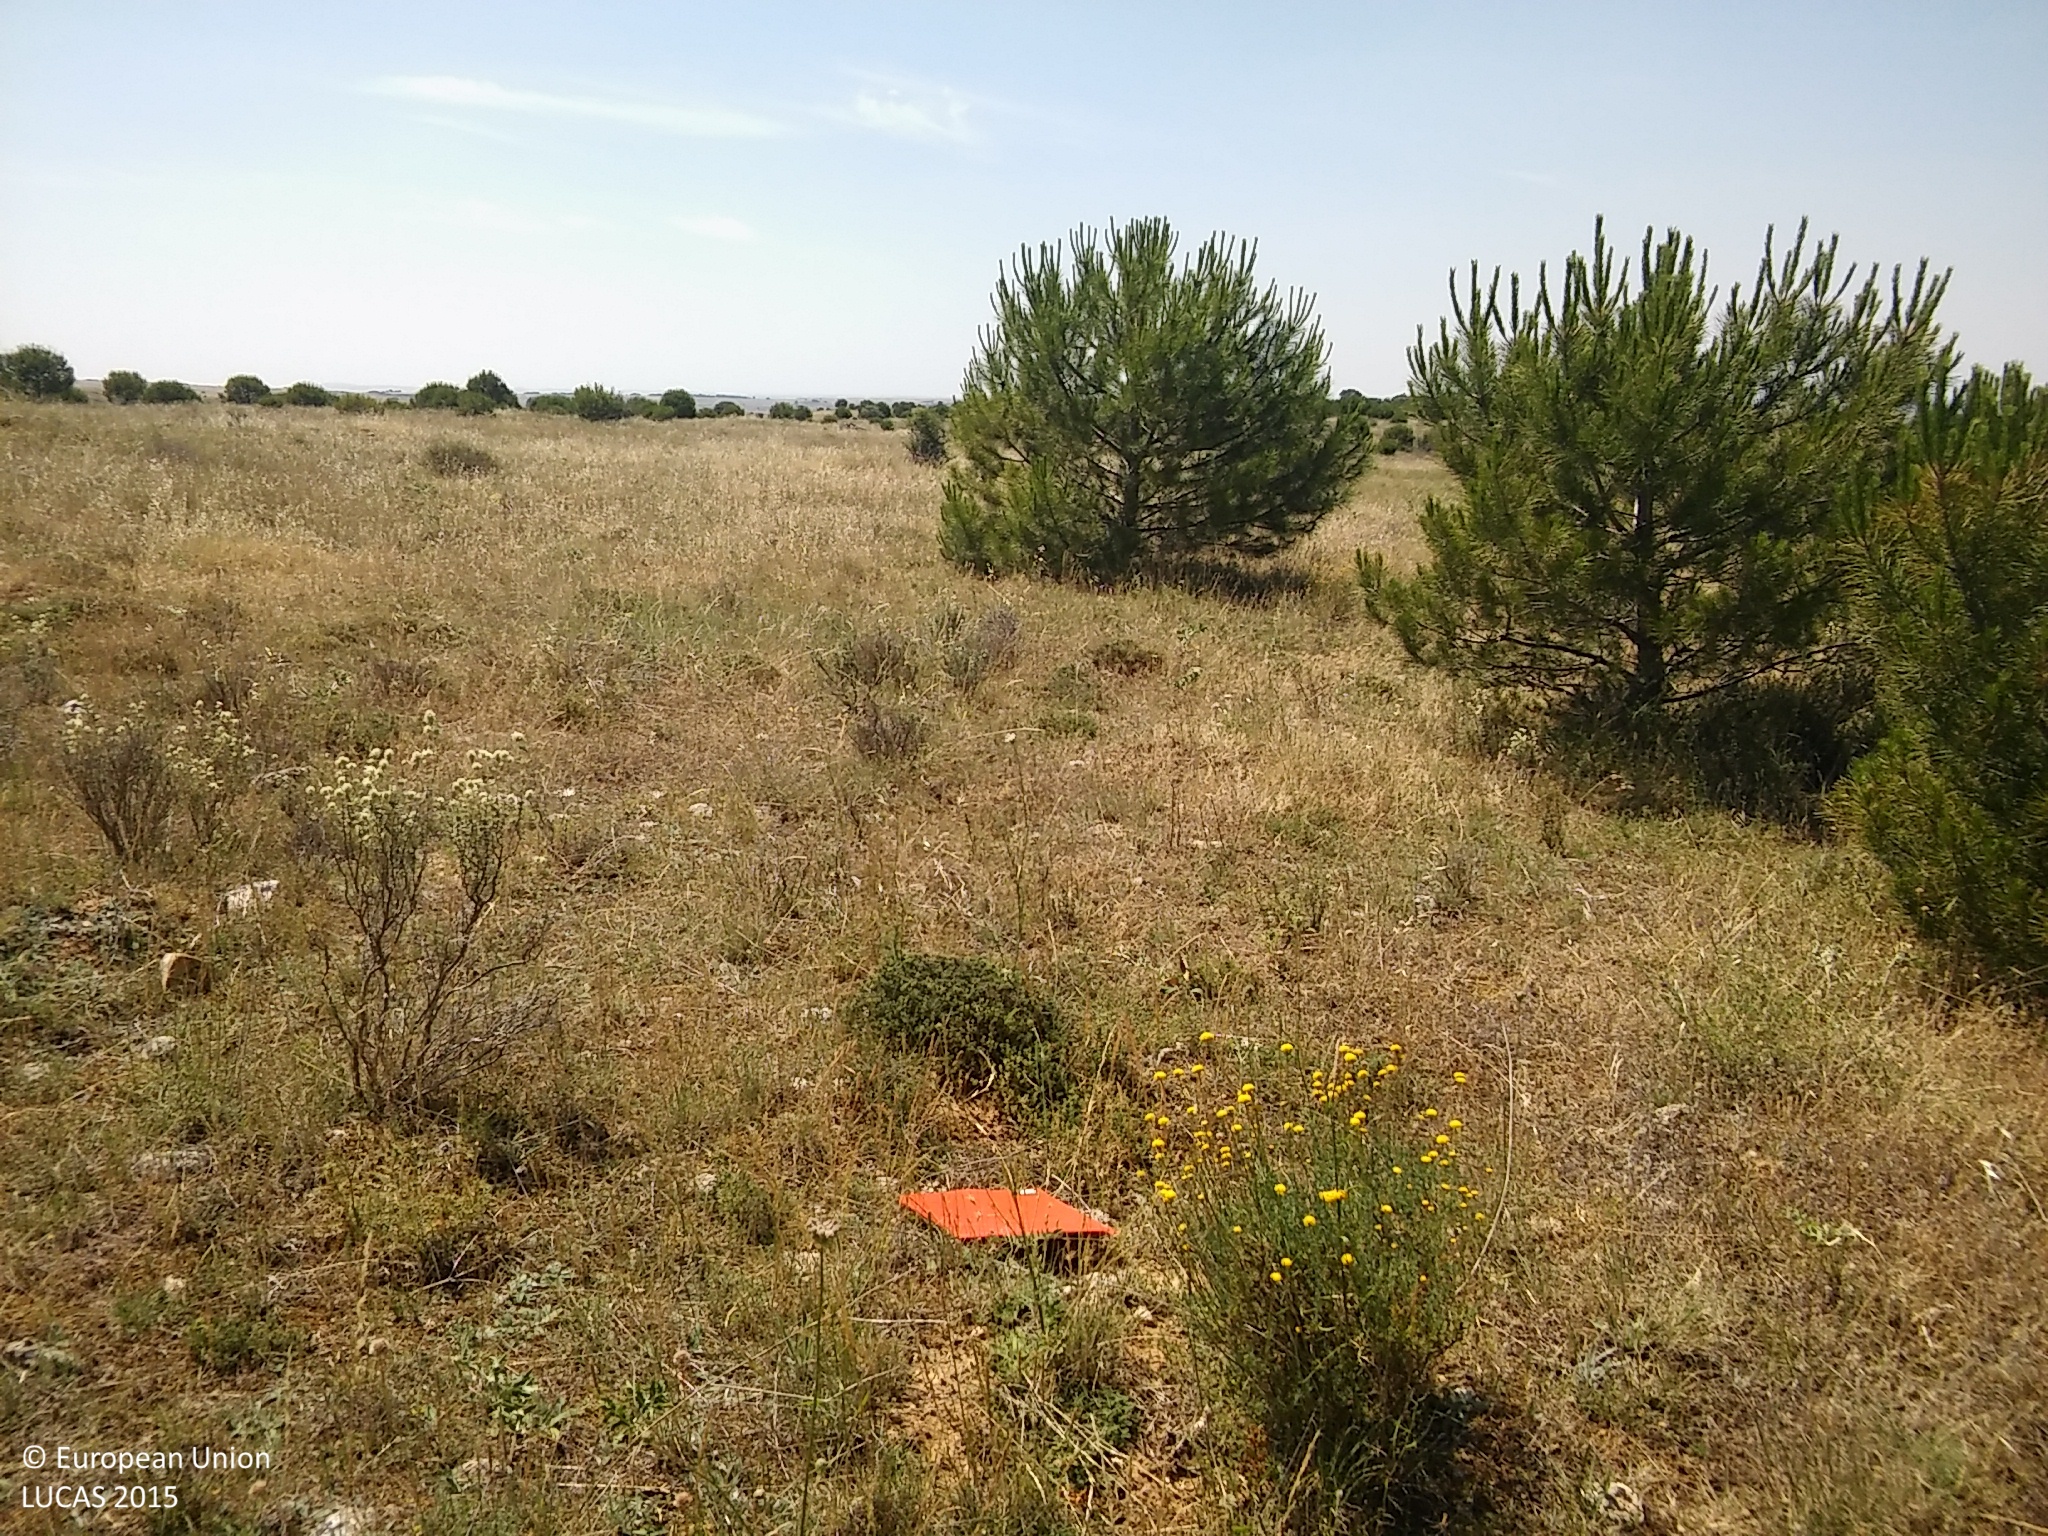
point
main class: Woodland
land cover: Pine dominated coniferous woodland
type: coniferous forest of the mediterranean region
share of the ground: 10 - 25 %
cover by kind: herbaceous plants 65 %, shrubs 25 %, coniferous forest trees 10 %
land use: Forestry
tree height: < 5 m
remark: Nursery
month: June
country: ES
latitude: 41.1128
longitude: -3.9716
